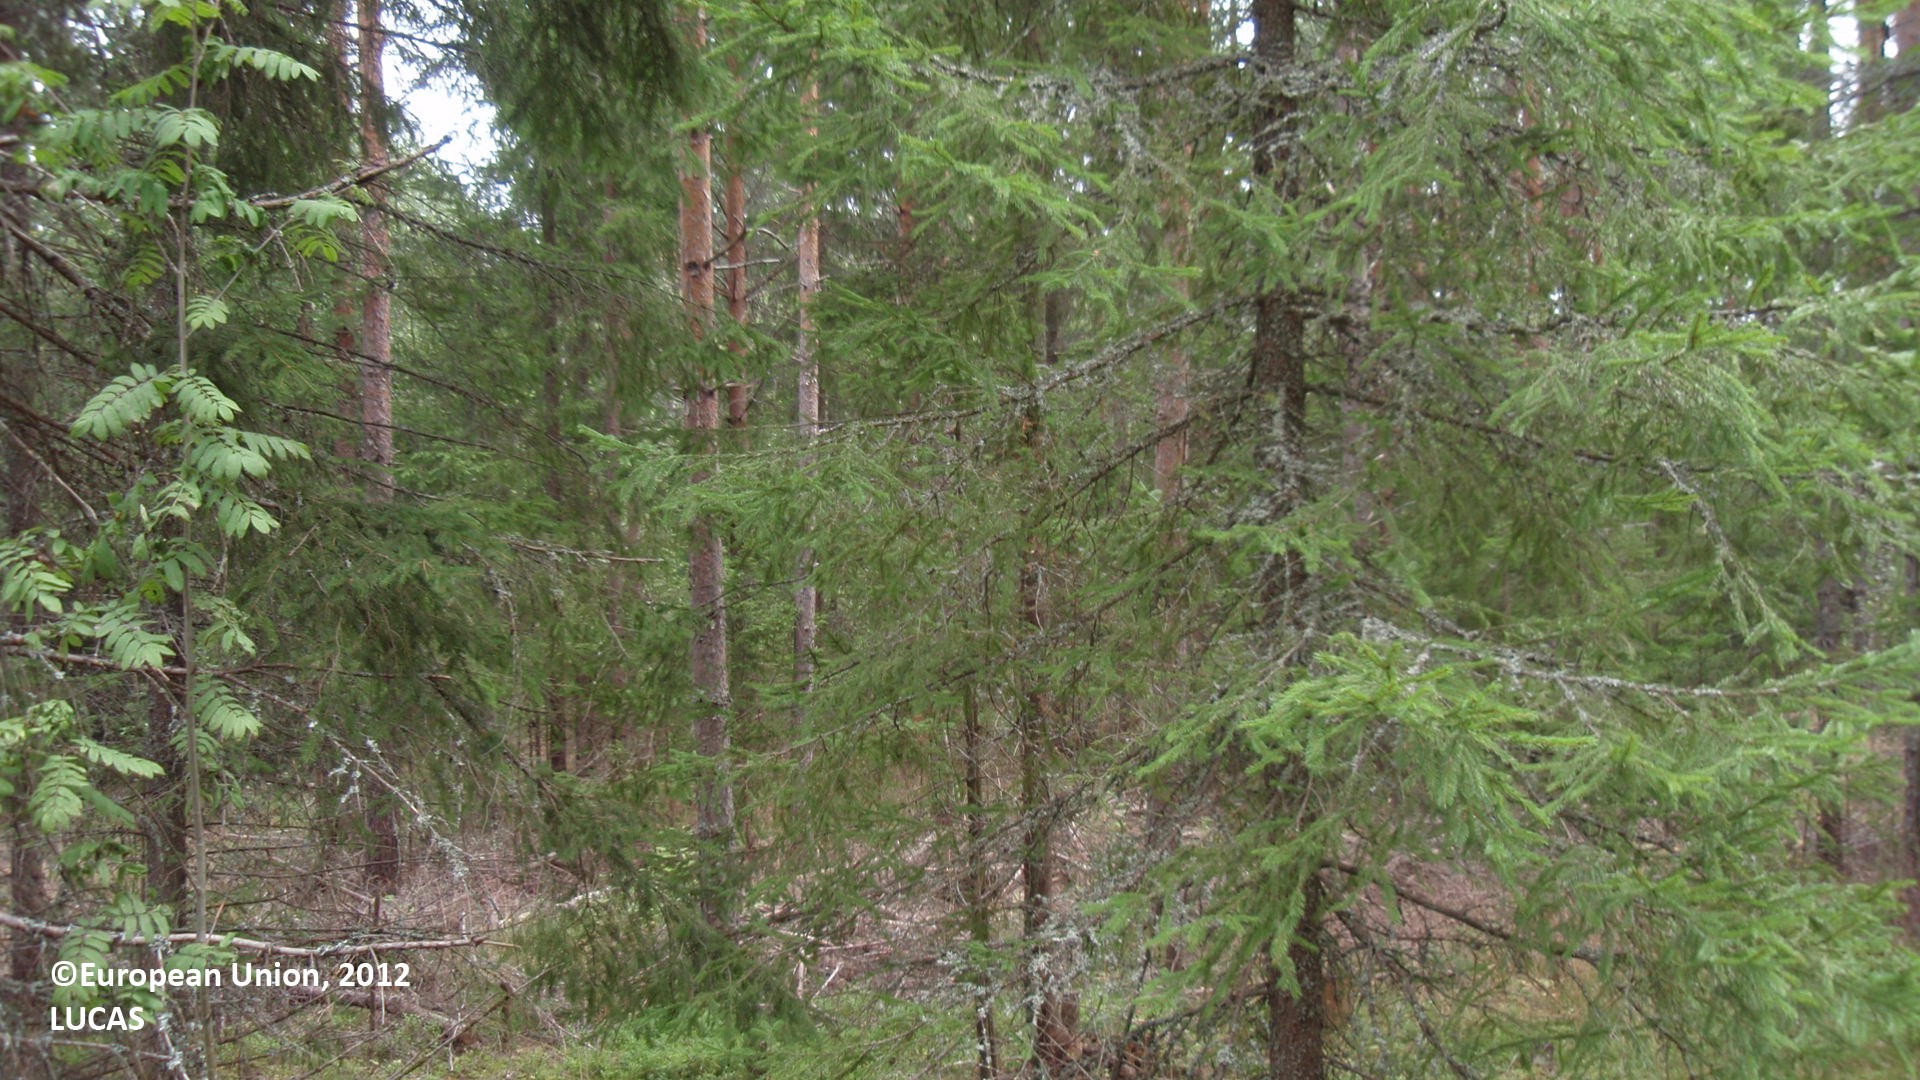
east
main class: Shrubland
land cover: Shrubland with sparse tree cover
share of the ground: > 75 %
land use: Forestry
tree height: < 5 m
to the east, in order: Shrubland with sparse tree cover; Spruce dominated mixed woodland; Broadleaved woodland; Pine dominated coniferous woodland; Grassland with sparse tree/shrub cover; Ditches and canals; Paved roads, cycling and walking lanes; Ditches and canals; Grassland with sparse tree/shrub cover; Electric lines; Grassland with sparse tree/shrub cover; Electric lines; Paved roads, cycling and walking lanes; Pine dominated mixed woodland
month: August
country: FI
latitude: 61.0979
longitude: 27.6012
